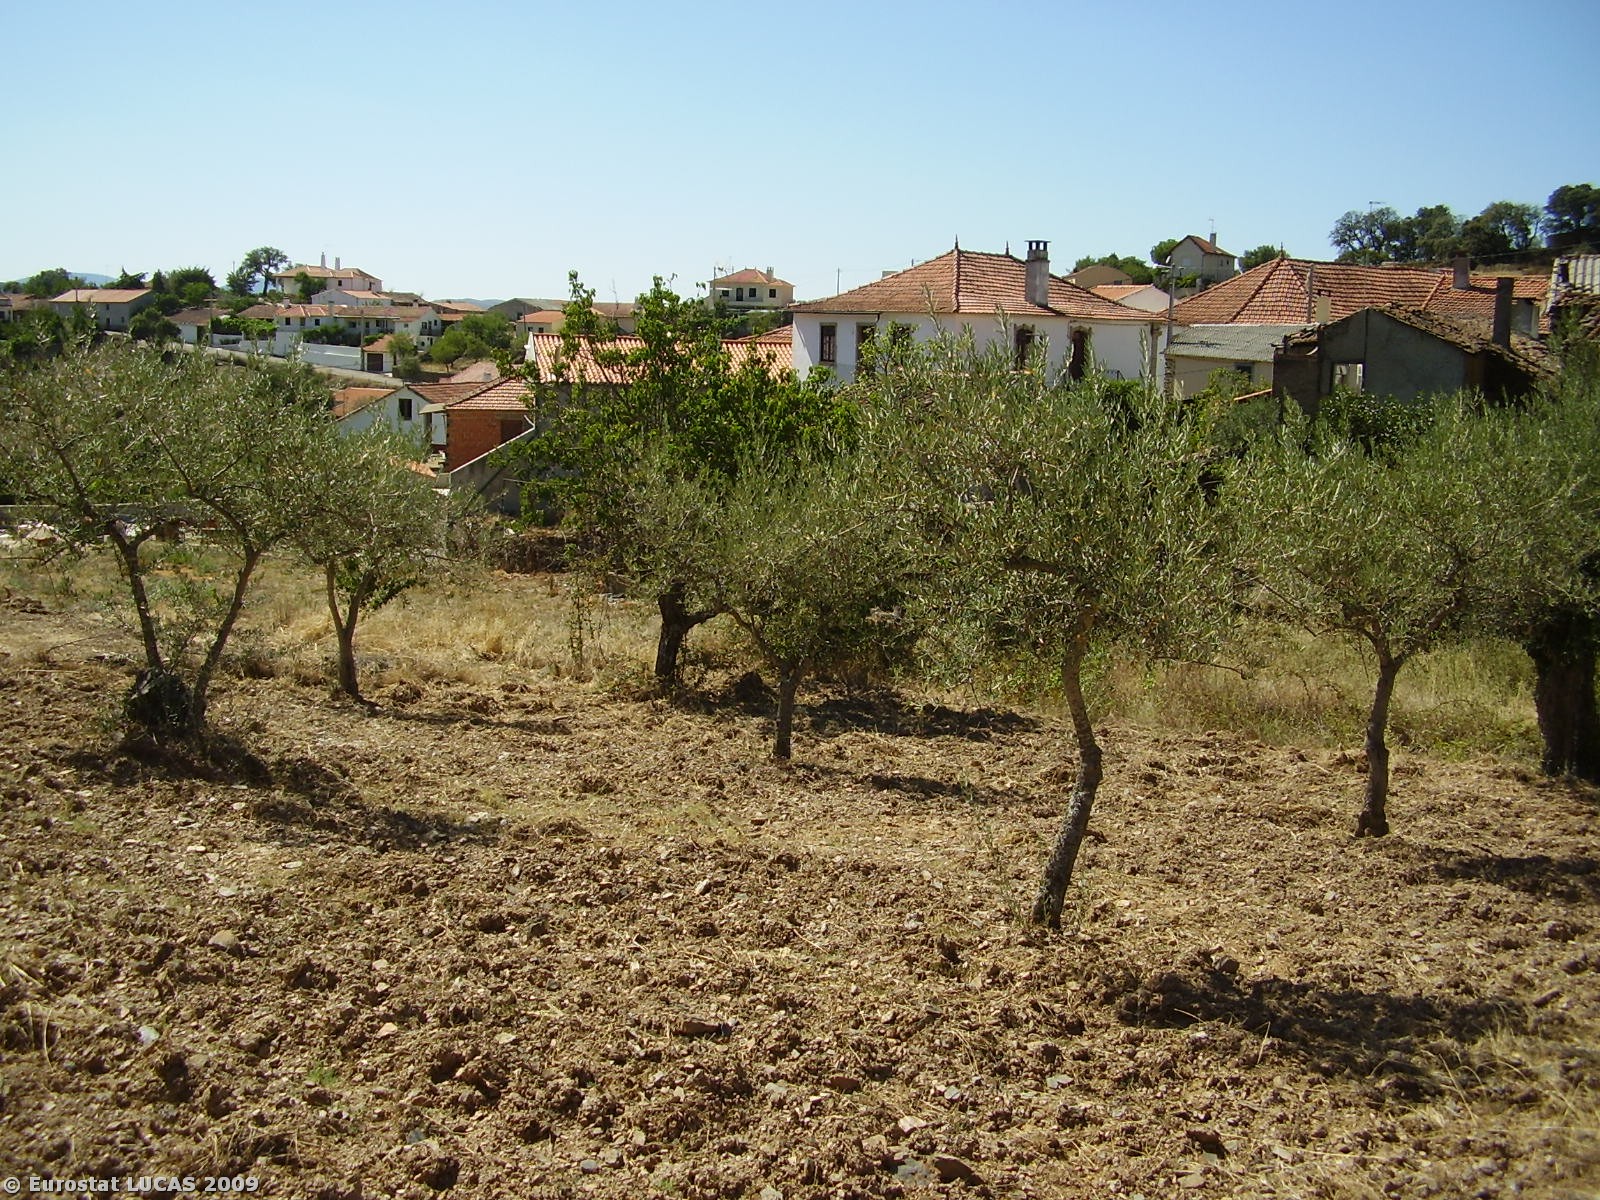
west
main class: Cropland
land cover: Olive groves
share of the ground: 10 - 25 %
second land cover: Spontaneously vegetated surfaces
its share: 10 - 25 %
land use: Agriculture (excluding fallow land and kitchen gardens)
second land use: Fallow land
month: August
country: PT
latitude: 41.2432
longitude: -6.7749
